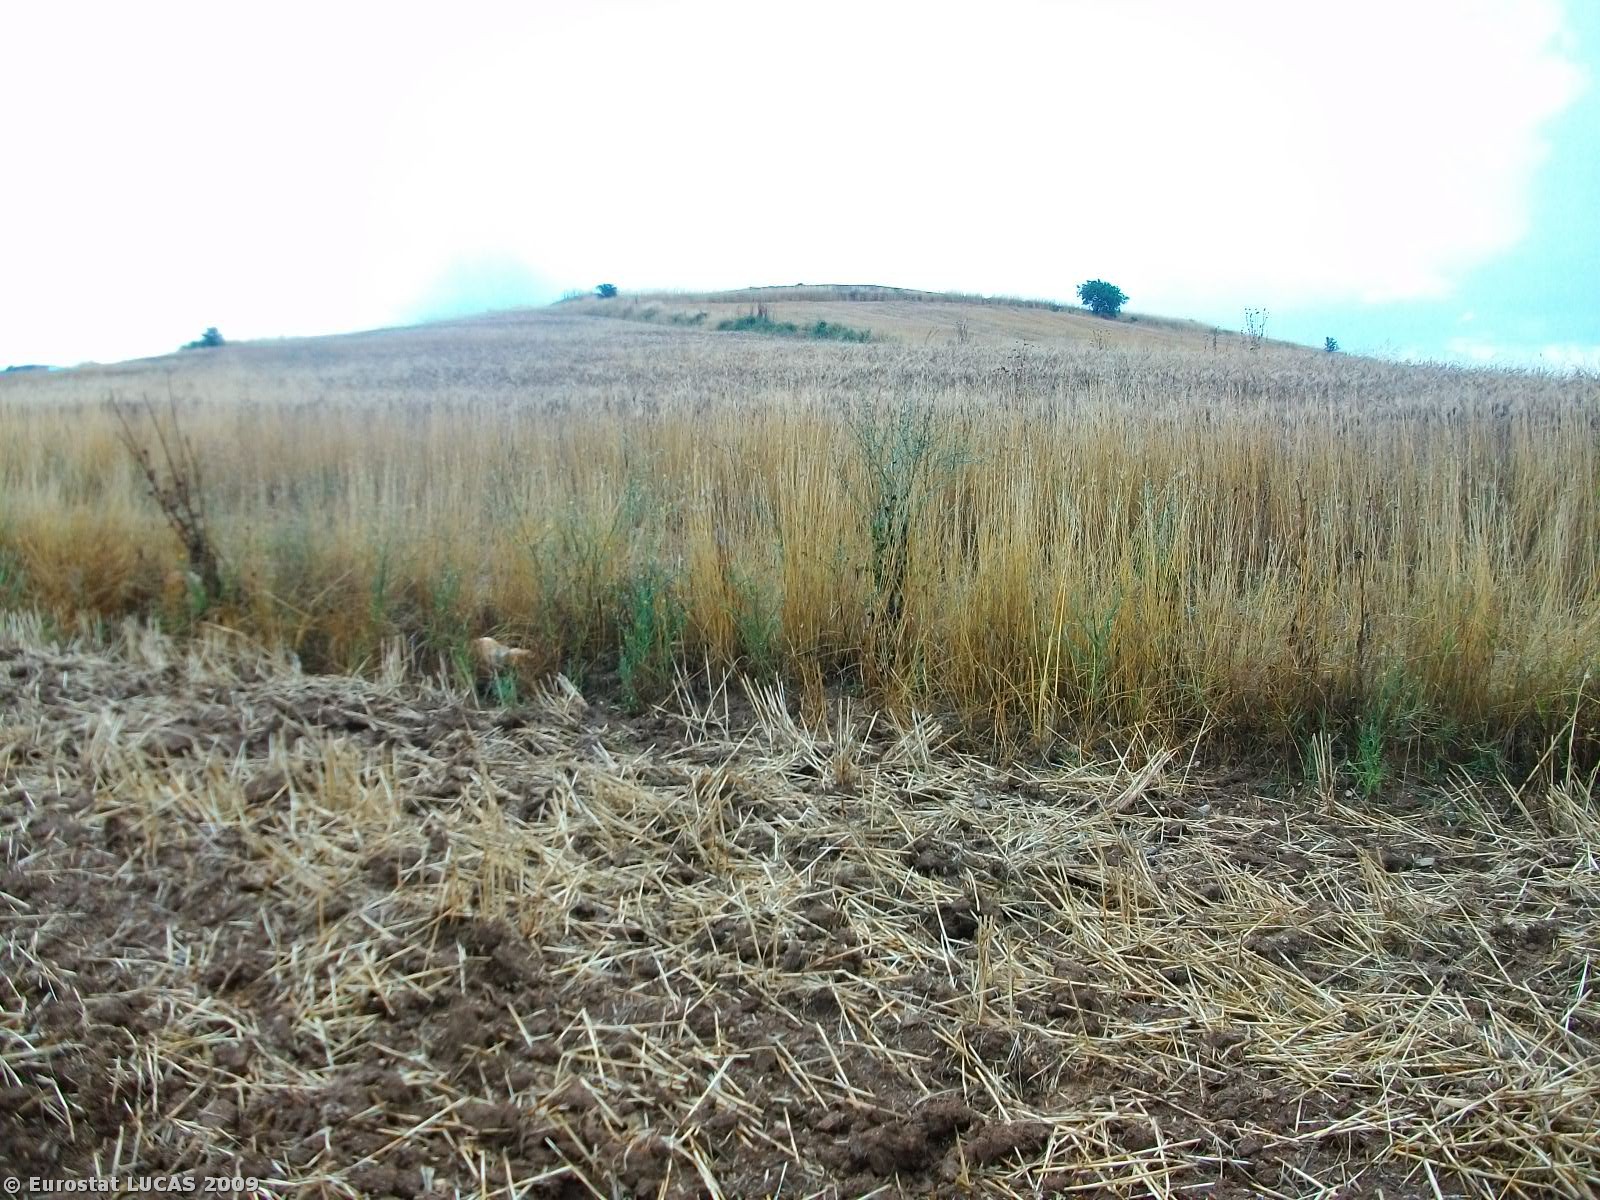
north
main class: Cropland
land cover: Barley
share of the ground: < 10 %
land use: Agriculture (excluding fallow land and kitchen gardens)
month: June
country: GR
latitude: 40.9808
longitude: 22.9300
